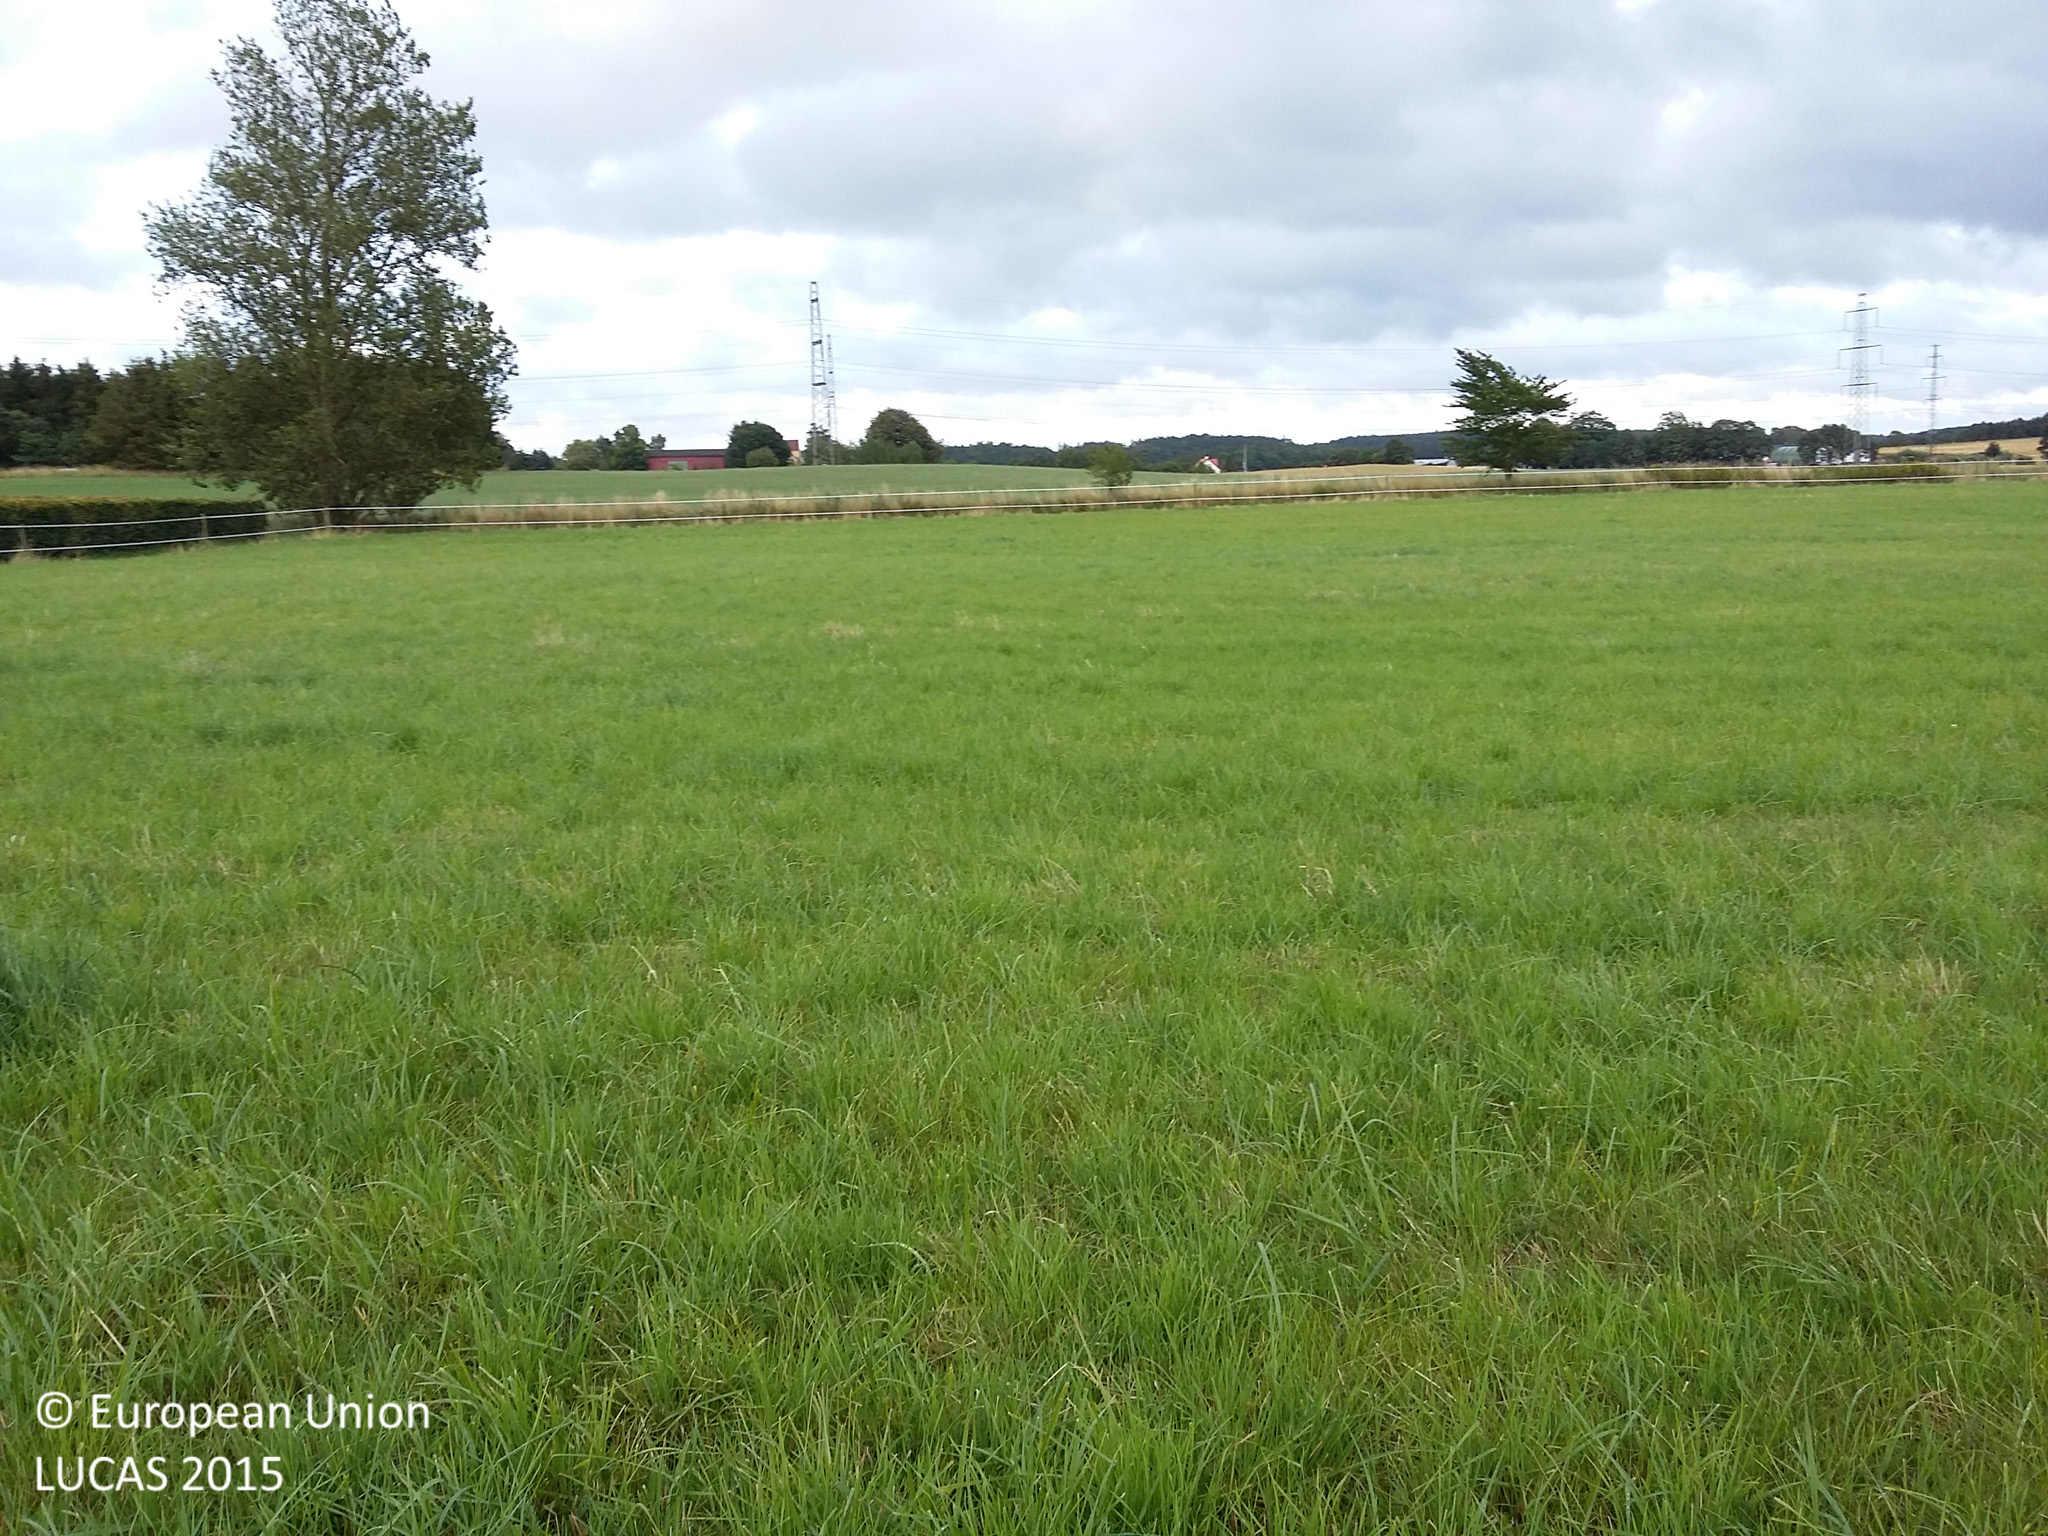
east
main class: Grassland
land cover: Grassland without tree/shrub cover
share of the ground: > 75 %
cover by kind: herbaceous plants 100 %
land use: Agriculture (excluding fallow land and kitchen gardens)
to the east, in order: Grassland without tree/shrub cover; Fences; Shruby margins; Temporary grasslands
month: July
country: DK
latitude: 55.8280
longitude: 12.1532
